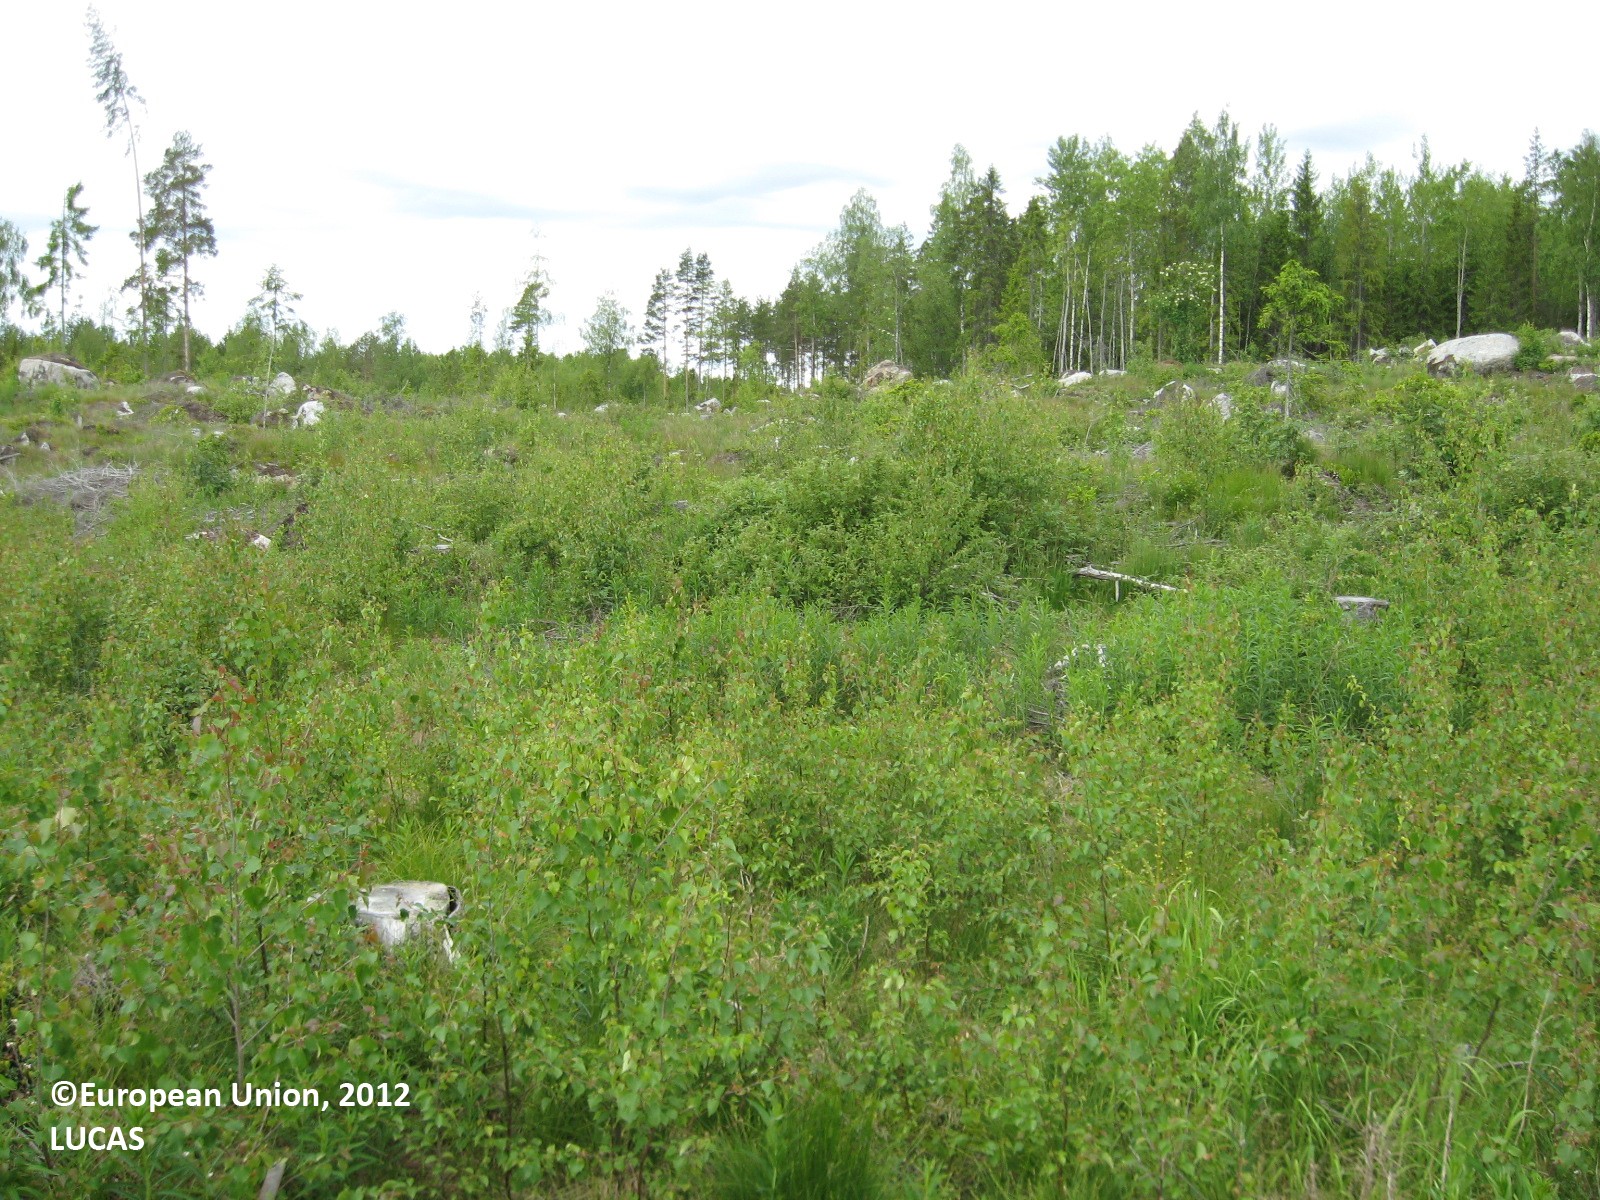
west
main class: Grassland
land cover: Grassland with sparse tree/shrub cover
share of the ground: > 75 %
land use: Forestry
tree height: < 5 m
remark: Clear cut
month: June
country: FI
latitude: 63.1033
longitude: 21.9518
